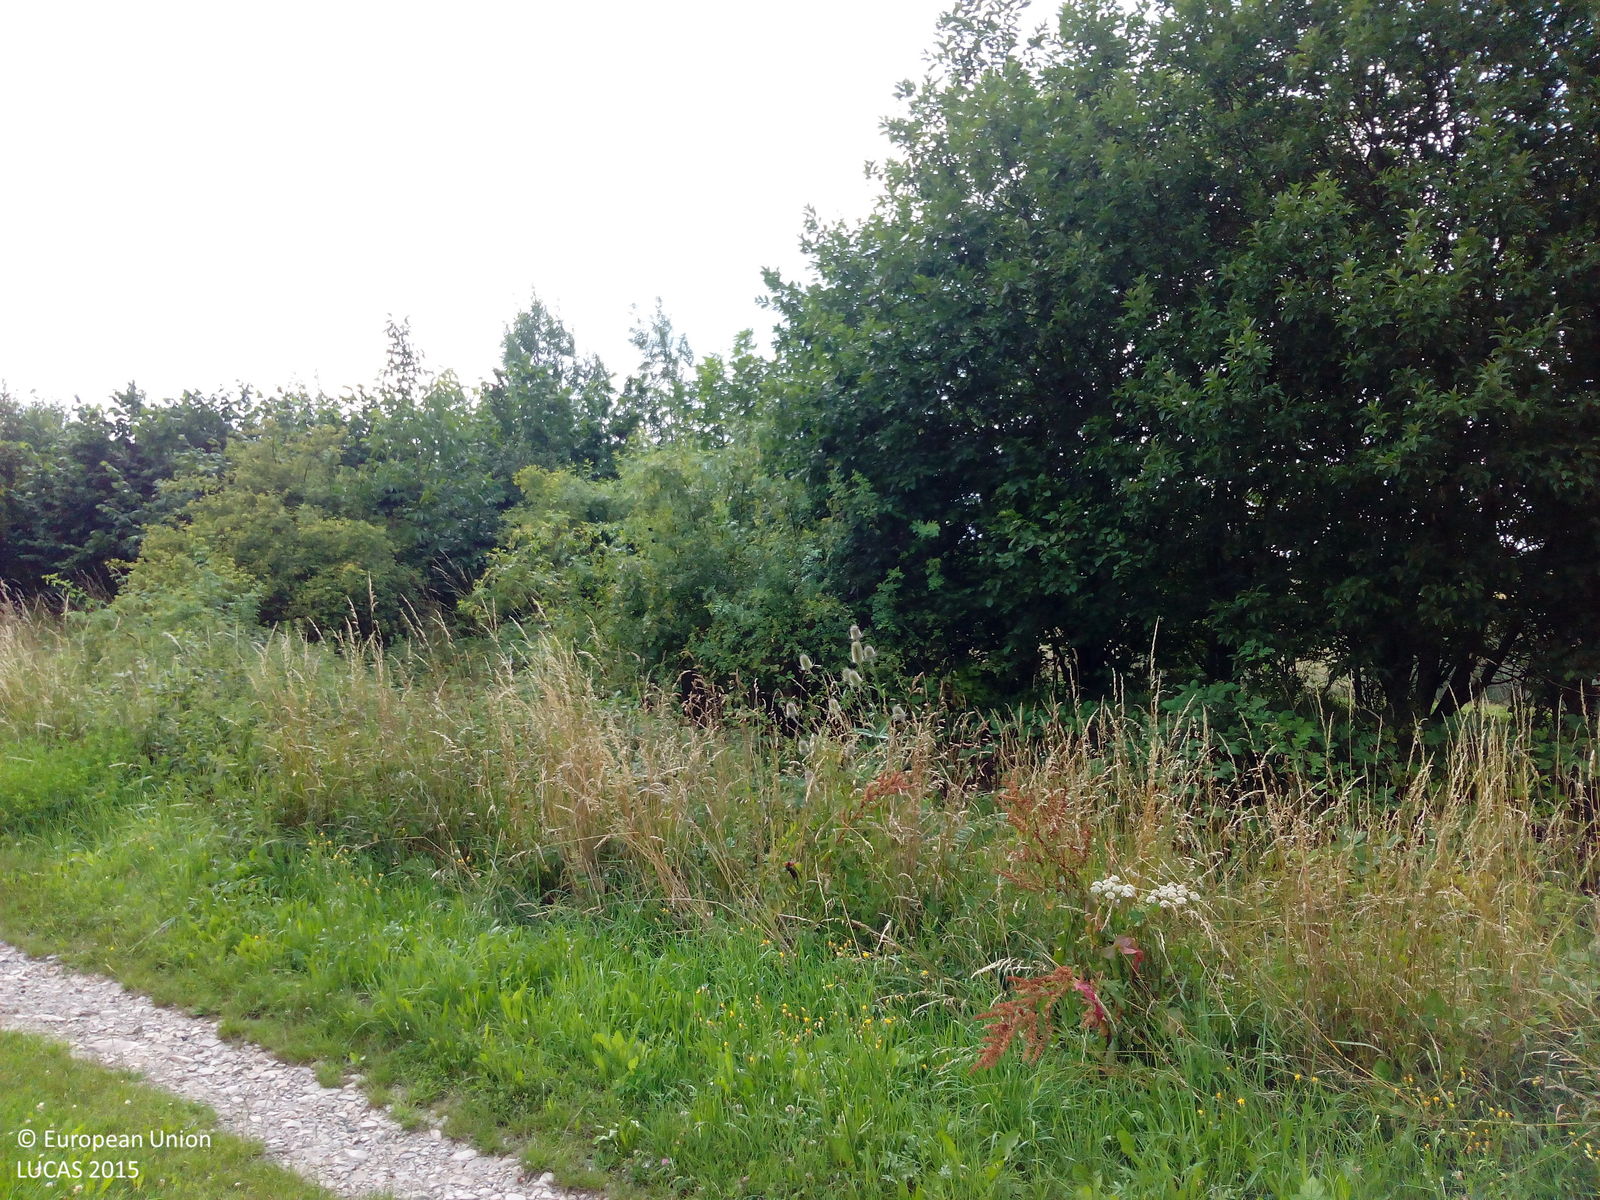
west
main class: Grassland
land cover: Grassland without tree/shrub cover
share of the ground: > 75 %
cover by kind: herbaceous plants 100 %
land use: Agriculture (excluding fallow land and kitchen gardens)
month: July
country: DE
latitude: 51.4247
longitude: 9.8706
